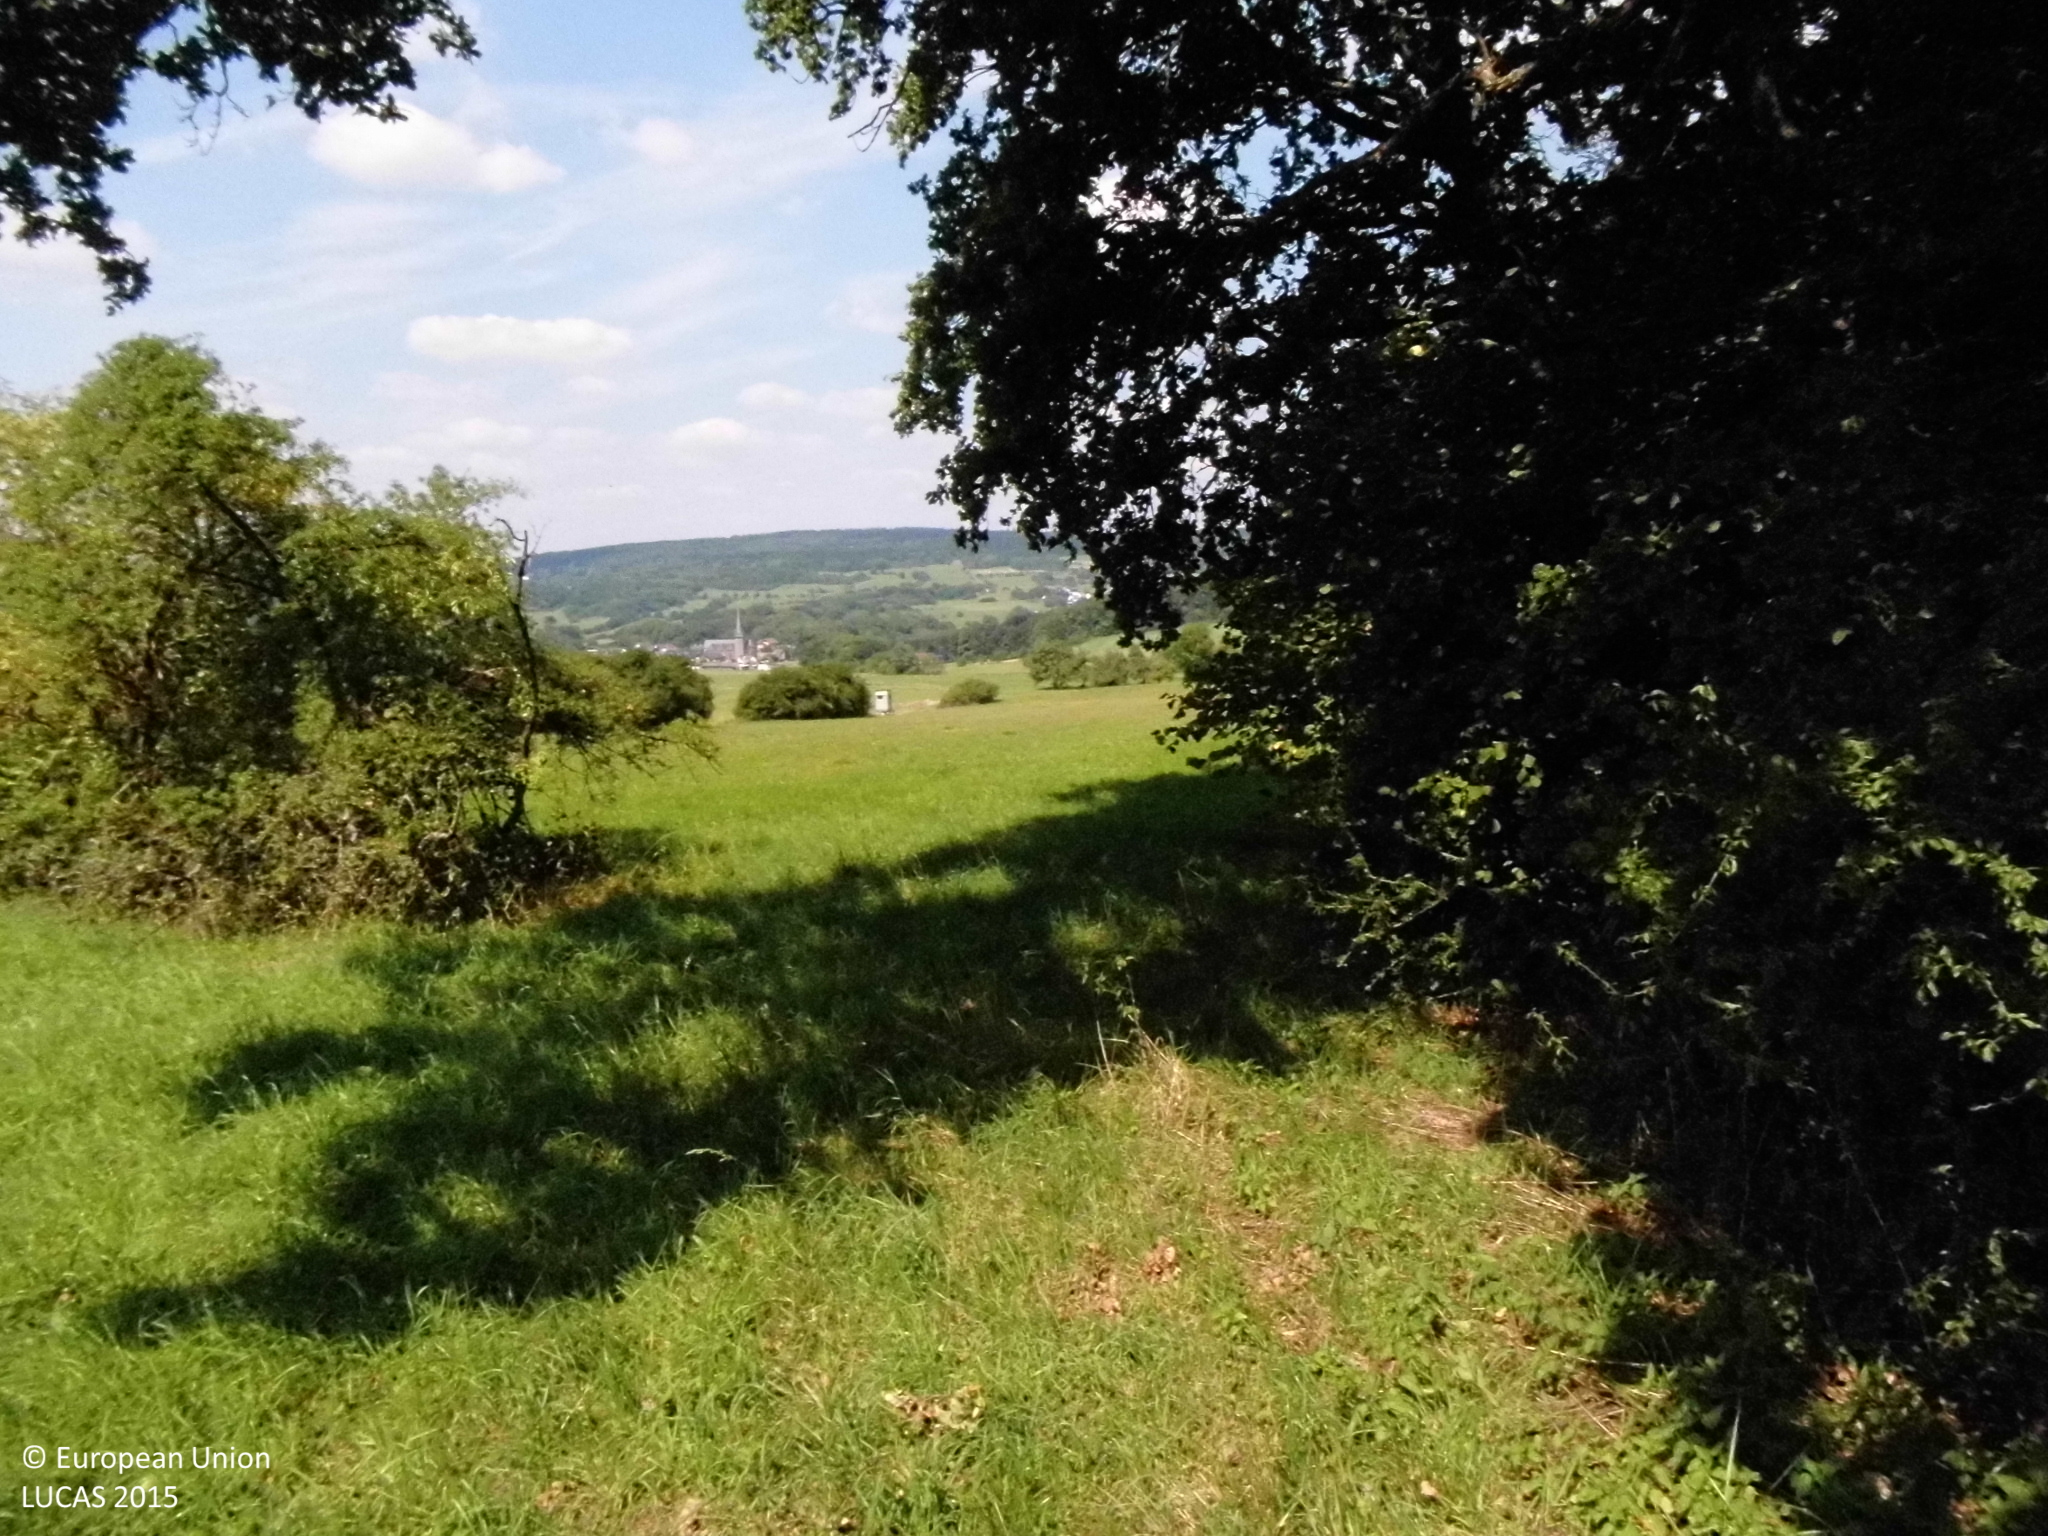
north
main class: Woodland
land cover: Broadleaved woodland
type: mesophytic deciduous forest
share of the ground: > 75 %
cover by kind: broadleaved forest trees 100 %
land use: Forestry
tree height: > 5 m
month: August
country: DE
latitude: 50.5645
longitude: 8.1227
